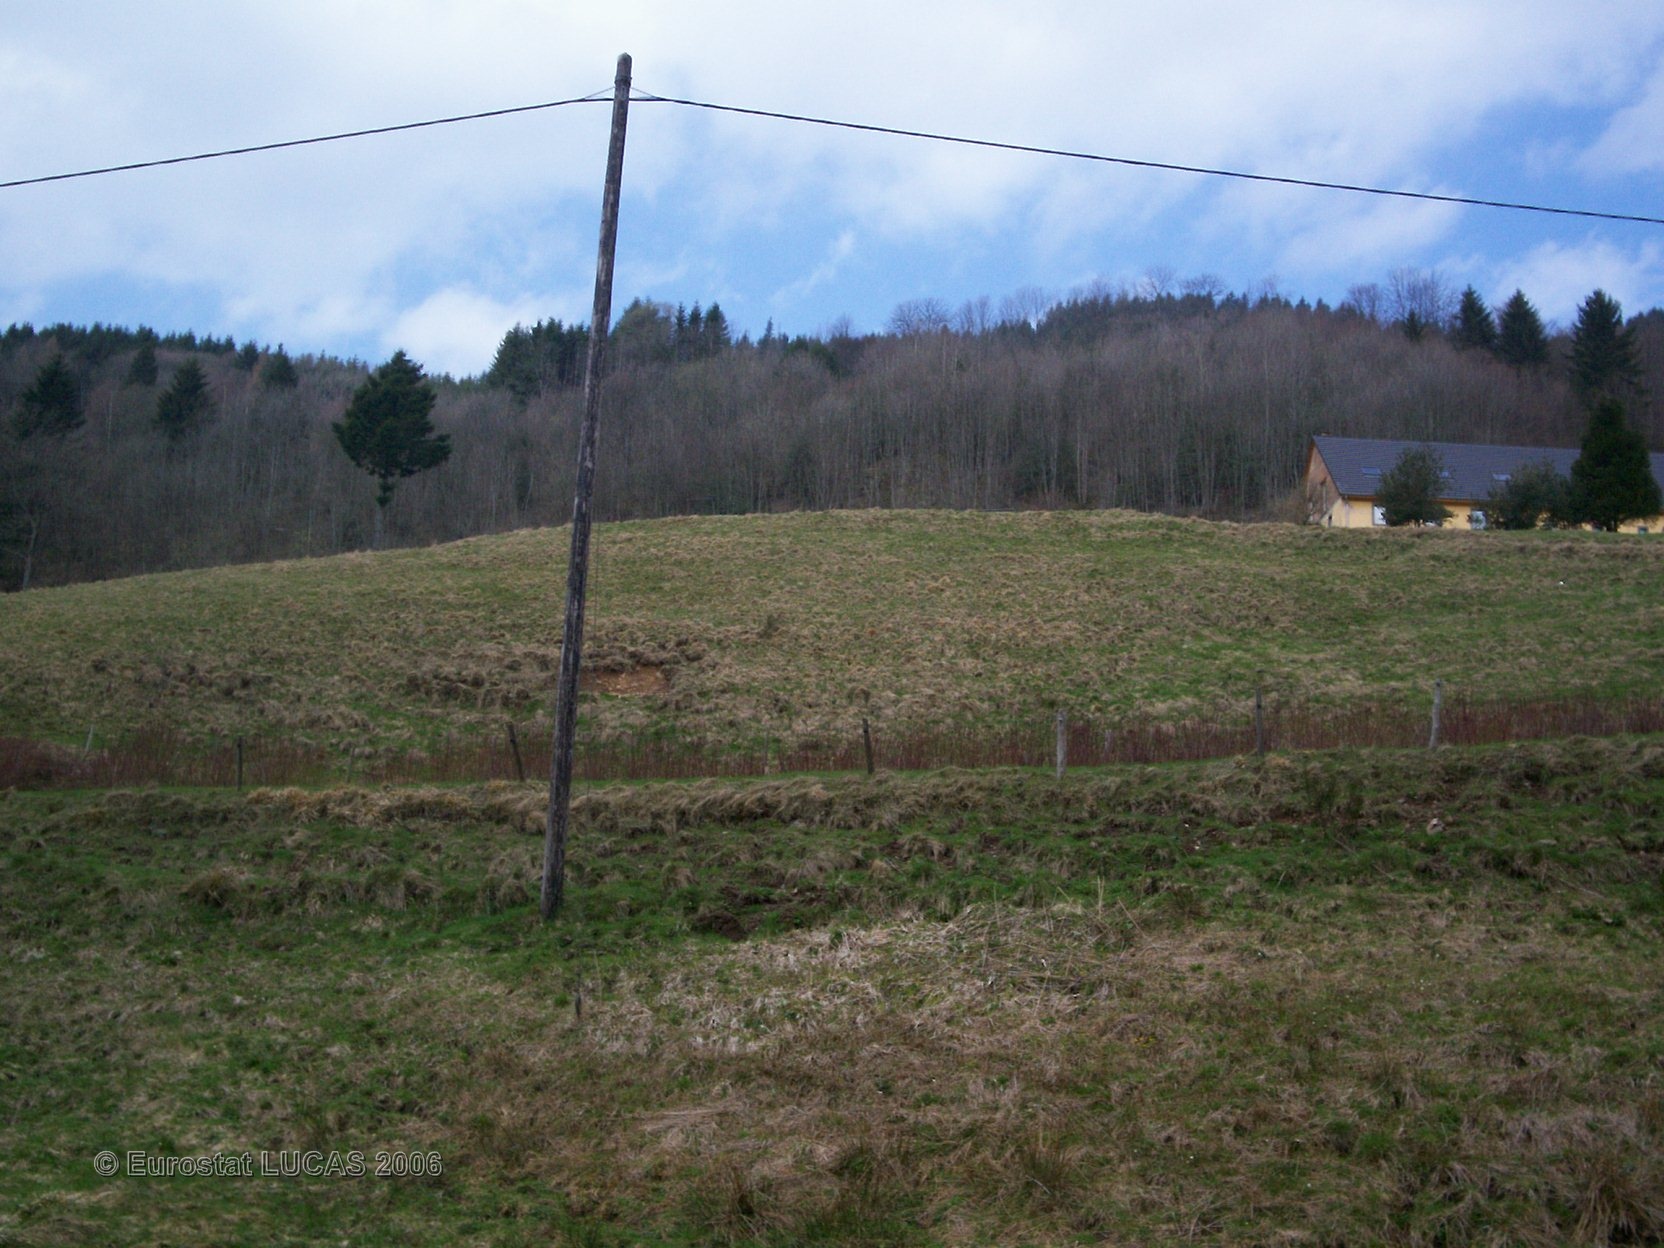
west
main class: Grassland
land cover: Grassland without tree/shrub cover
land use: Agriculture (excluding fallow land and kitchen gardens)
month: April
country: FR
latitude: 48.1857
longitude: 7.1091
